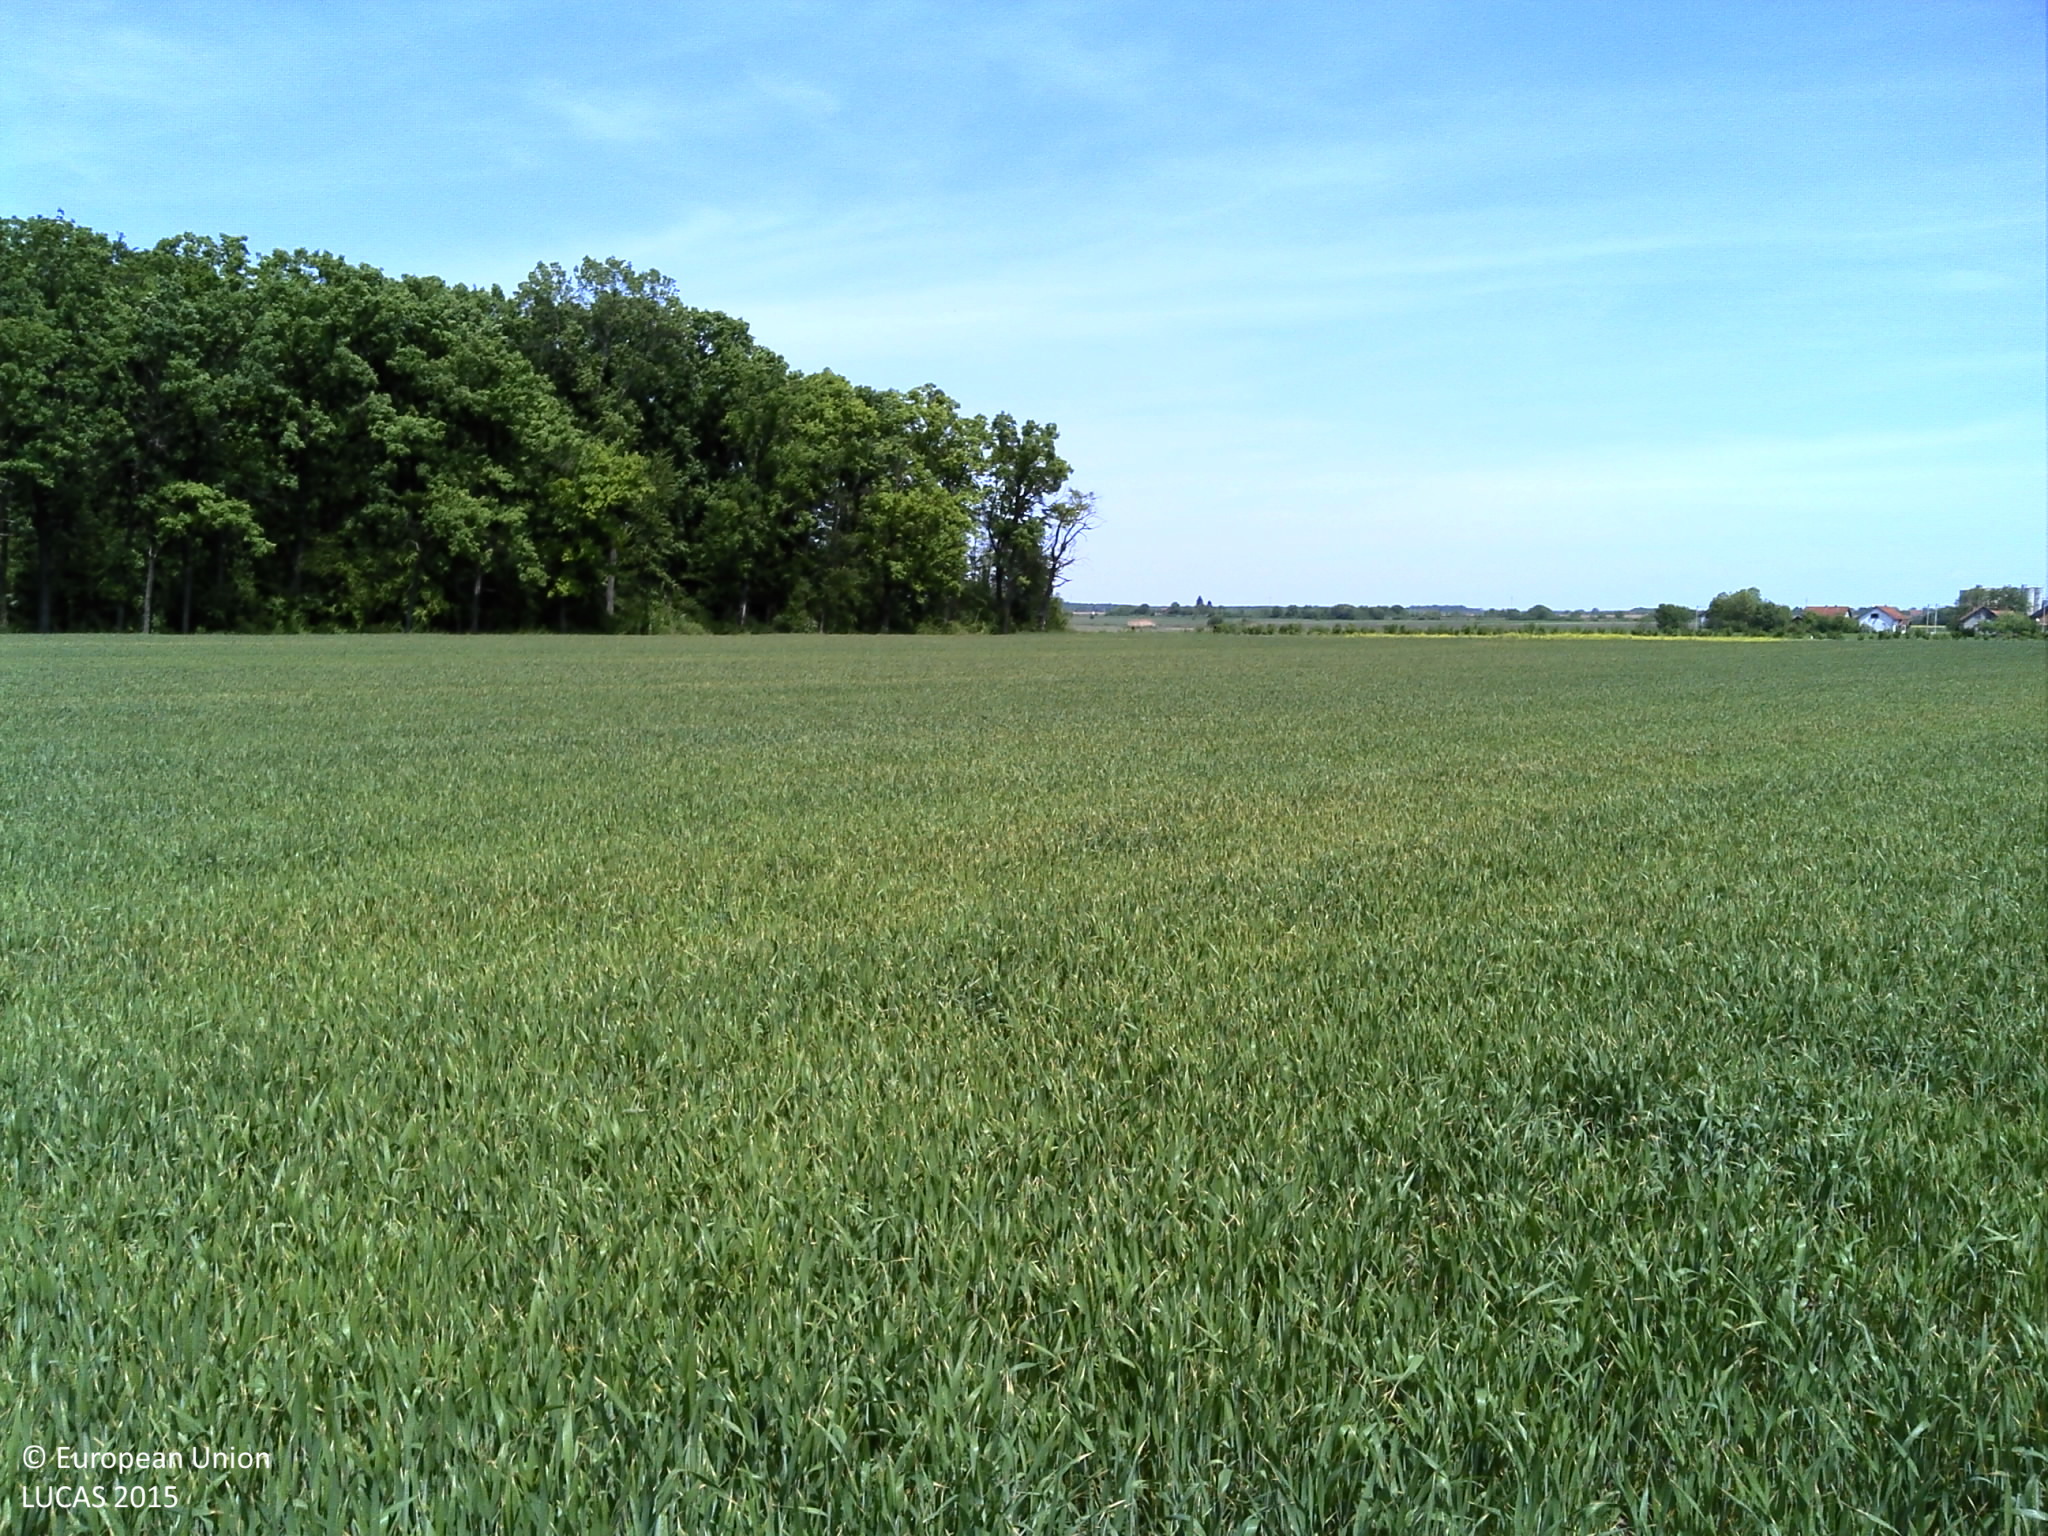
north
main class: Cropland
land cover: Common wheat
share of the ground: > 75 %
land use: Agriculture (excluding fallow land and kitchen gardens)
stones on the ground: < 10 %
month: May
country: HR
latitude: 45.2378
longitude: 18.8864
